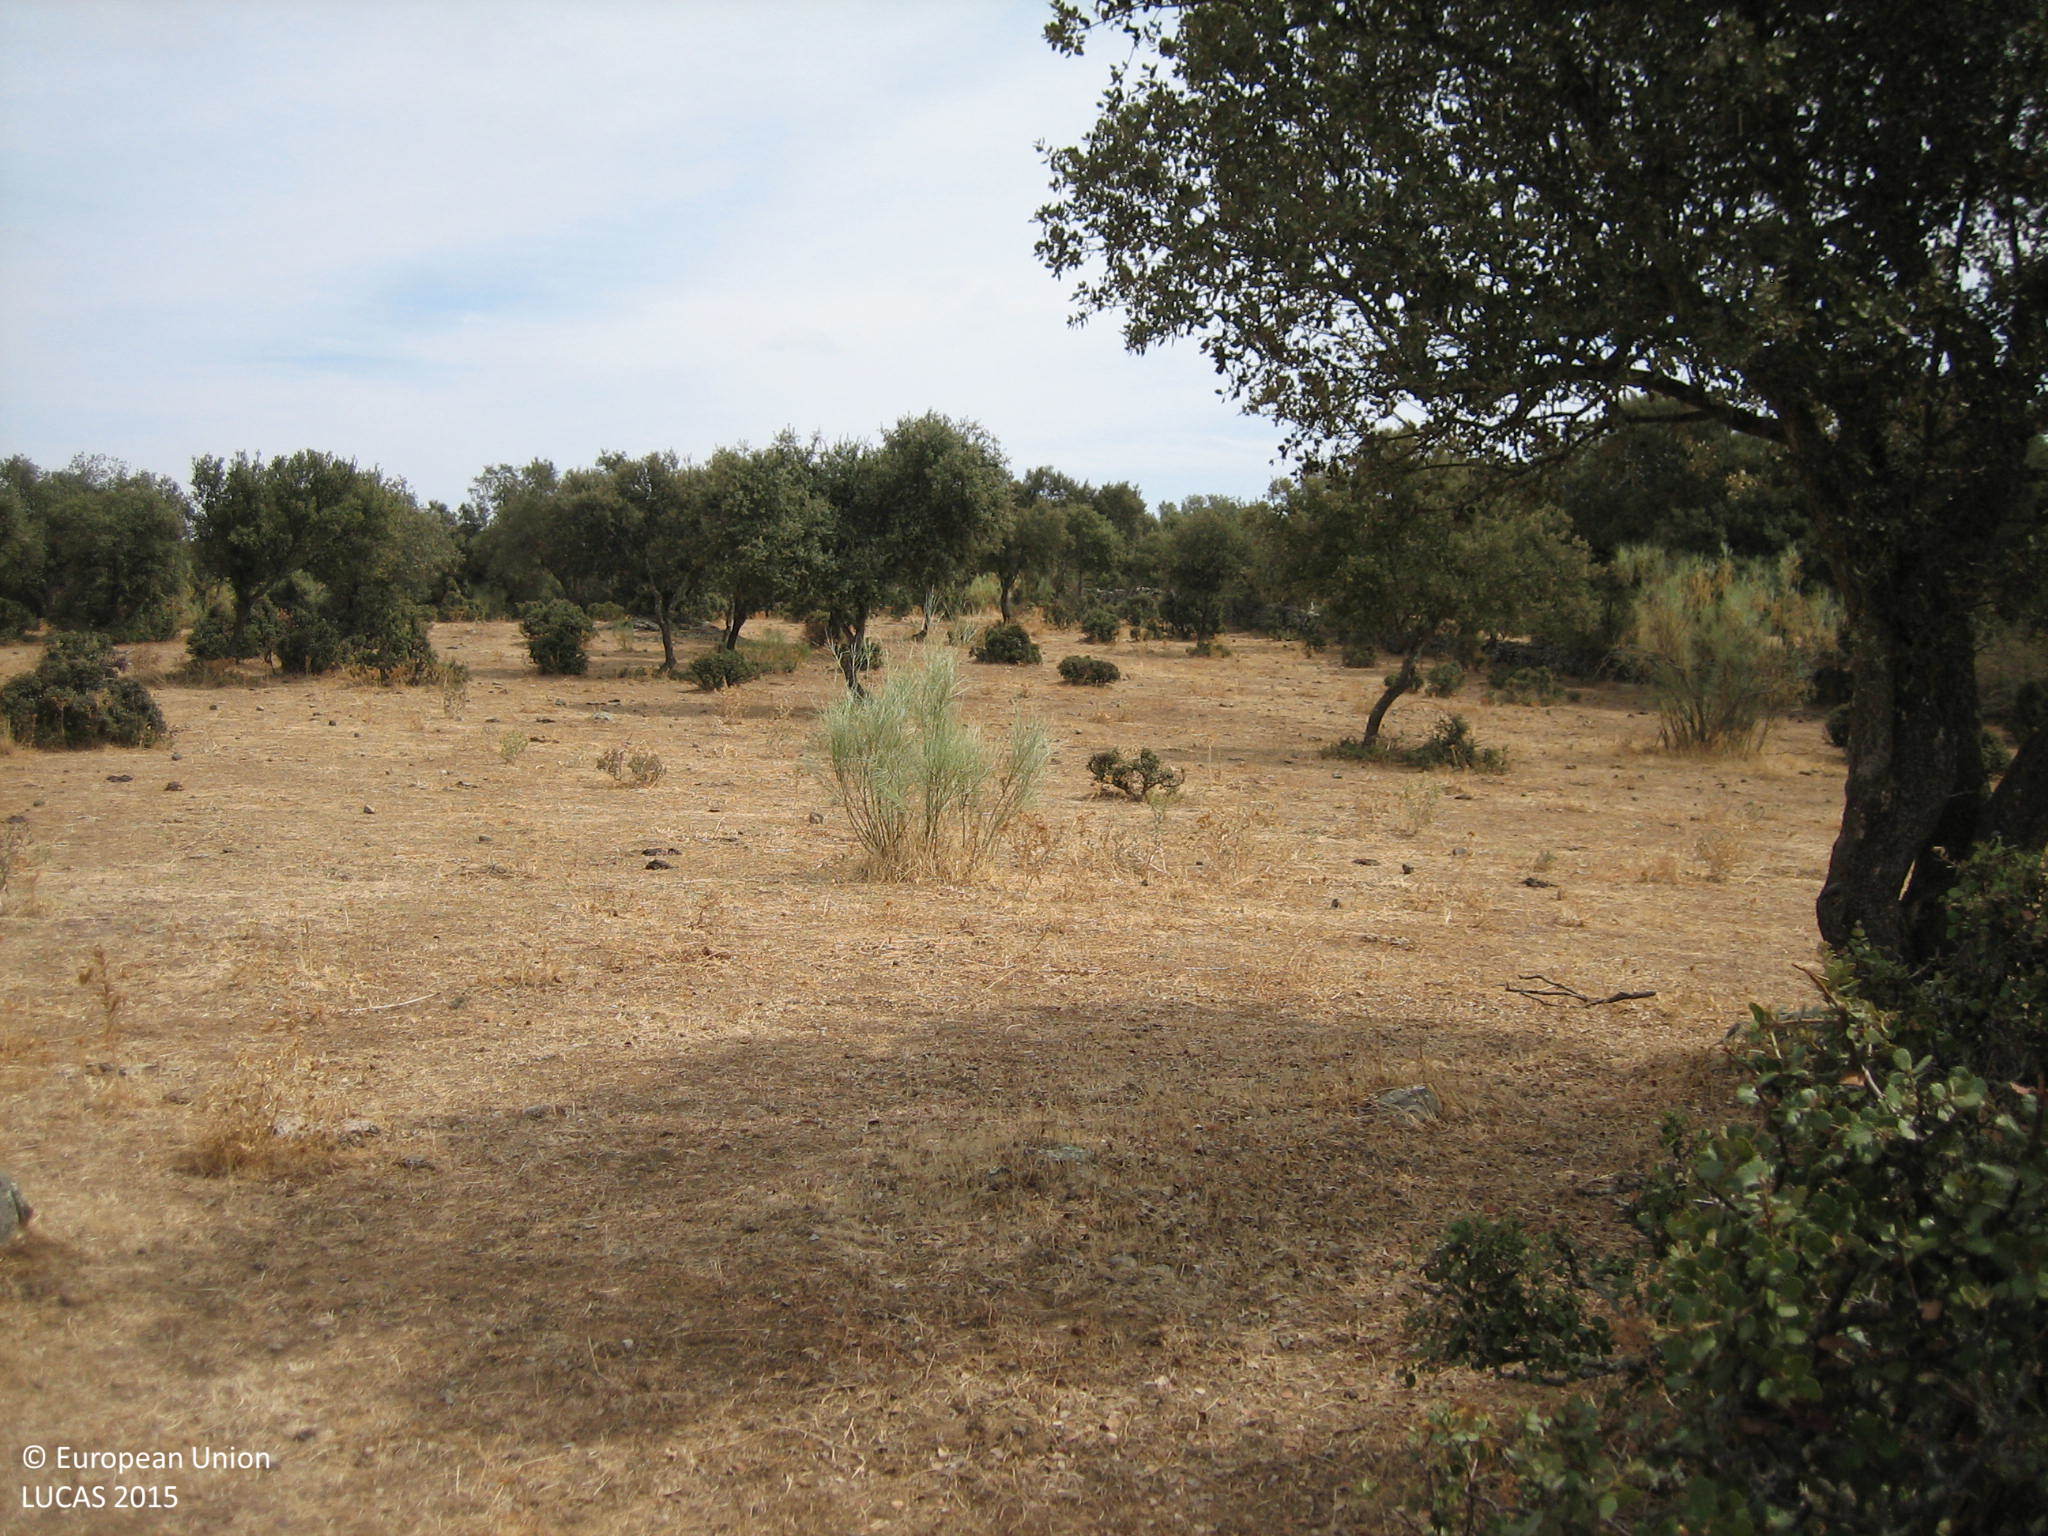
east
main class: Shrubland
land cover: Shrubland with sparse tree cover
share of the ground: 10 - 25 %
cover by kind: herbaceous plants 80 %, shrubs 15 %, broadleaved forest trees 5 %
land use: Forestry
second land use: Agriculture (excluding fallow land and kitchen gardens)
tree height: < 5 m
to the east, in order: Shrubland with sparse tree cover; Dry stone walls; Broadleaved woodland; Dry stone walls; Tracks; Dry stone walls; Broadleaved woodland
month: September
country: ES
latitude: 38.4974
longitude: -6.8815
